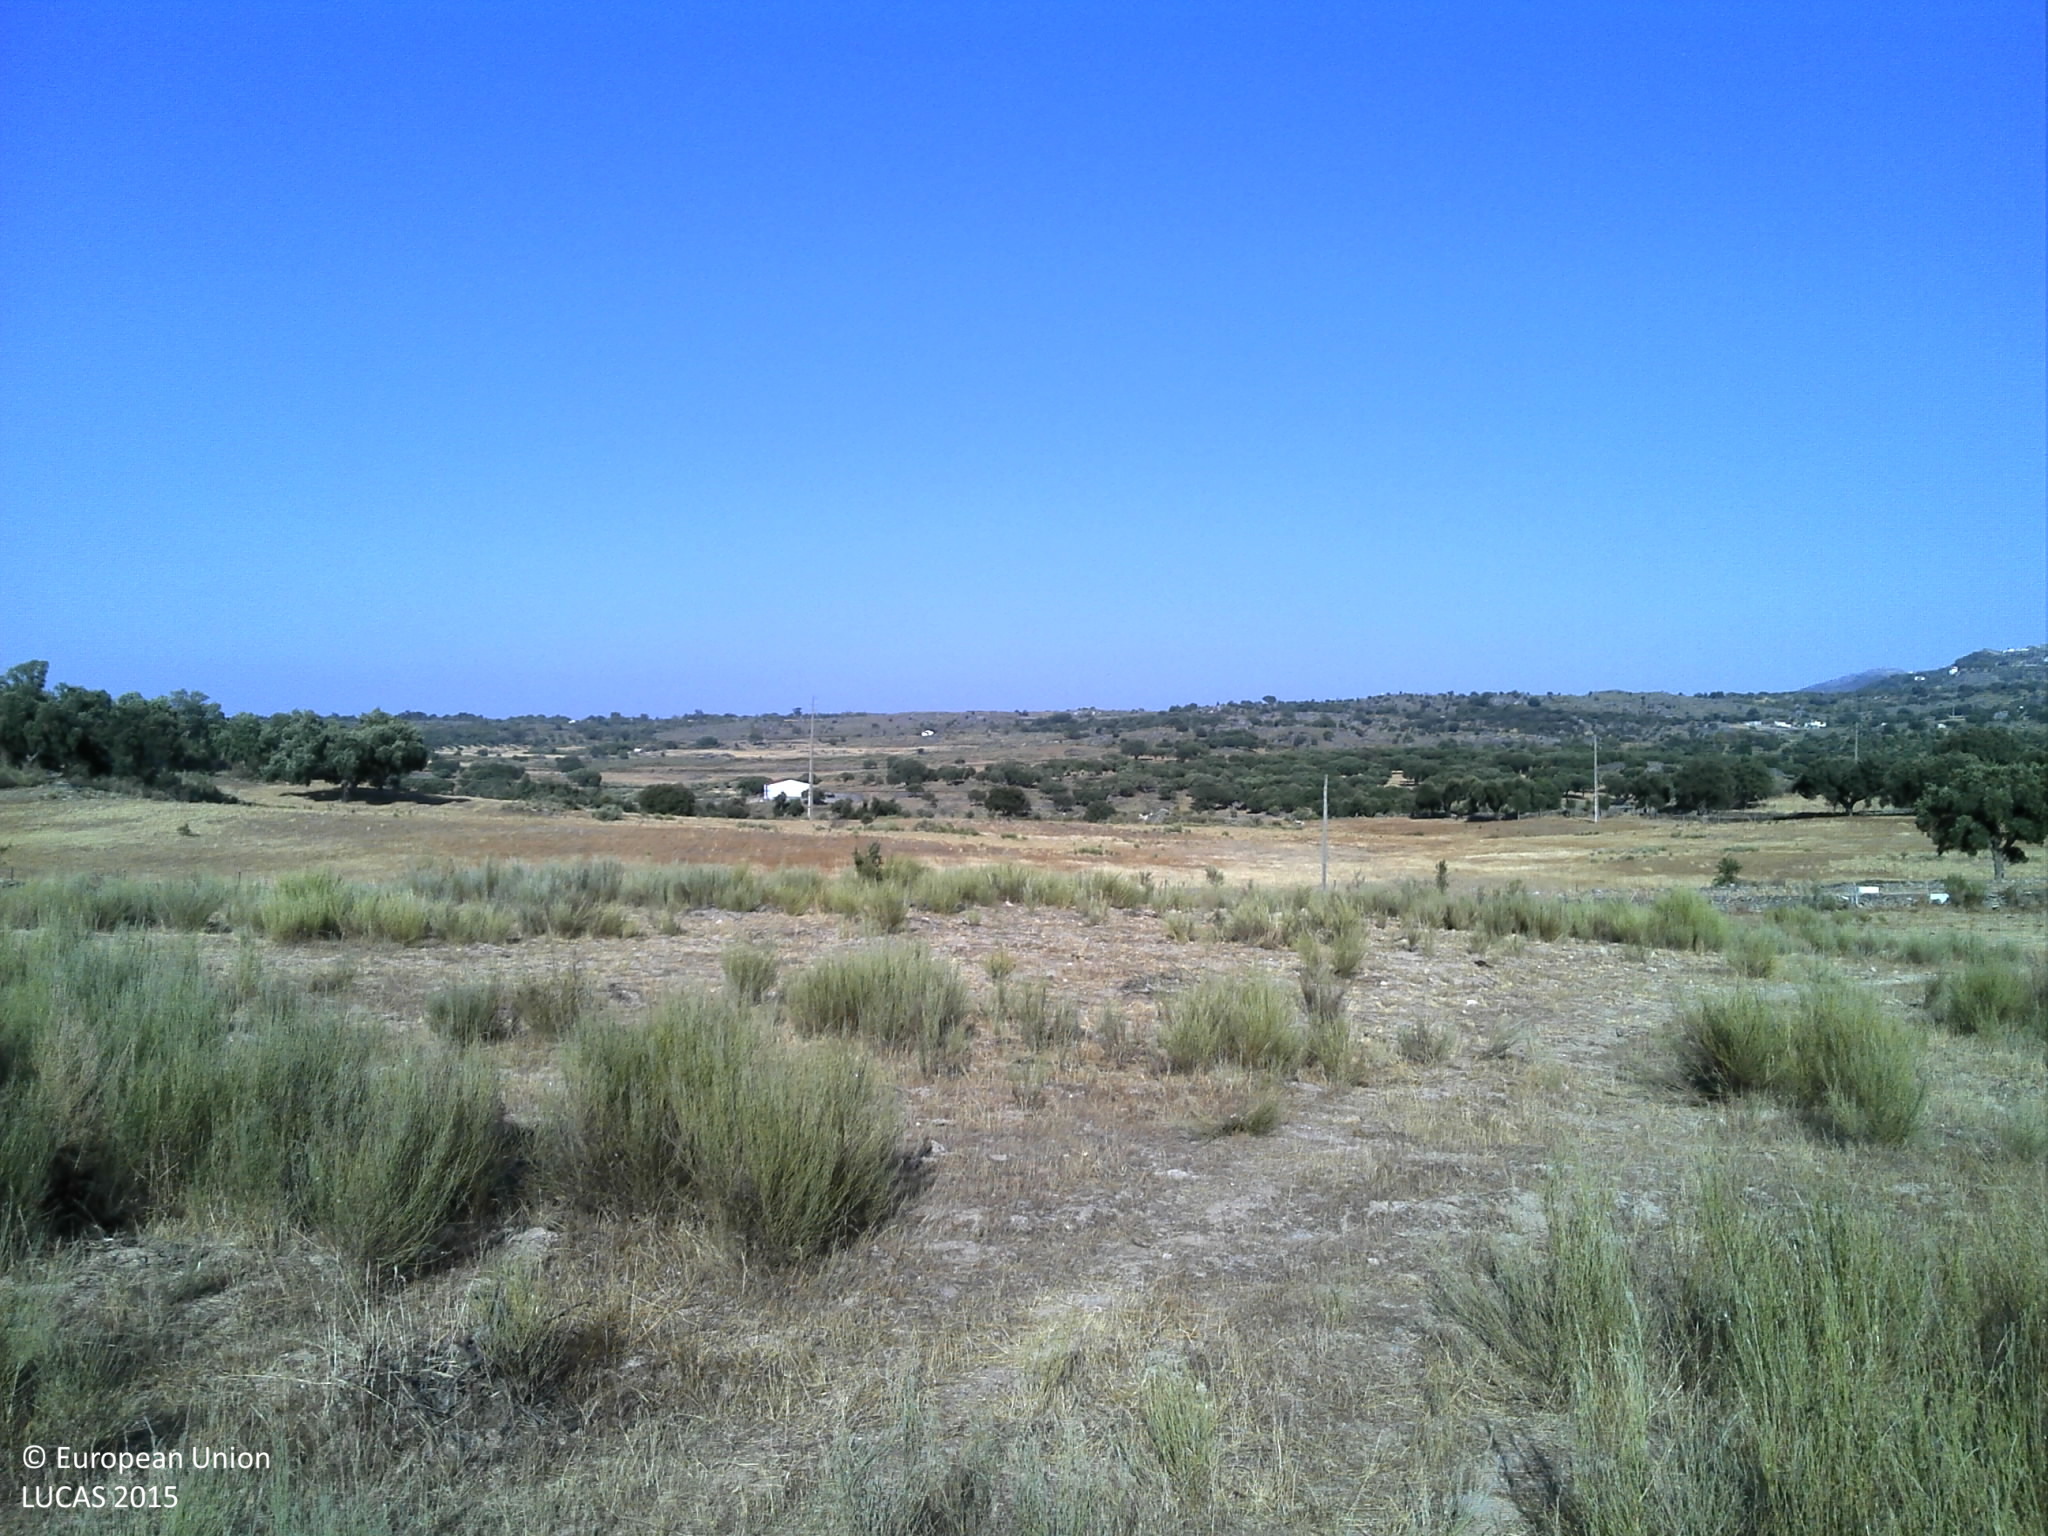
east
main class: Shrubland
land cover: Shrubland without tree cover
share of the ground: 25 - 50 %
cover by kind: unconsolidated bare surface 50 %, shrubs 30 %, herbaceous plants 20 %
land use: Agriculture (excluding fallow land and kitchen gardens)
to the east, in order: Shrubland without tree cover; Grassland with sparse tree/shrub cover; Shruby margins; Fences; Dry stone walls; Grass margins; Paved roads, cycling and walking lanes; Grass margins; Dry stone walls; Fences; Grass margins; Other structural elements; Electric lines; Spontaneously vegetated surfaces
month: August
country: PT
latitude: 39.4360
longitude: -7.5082
